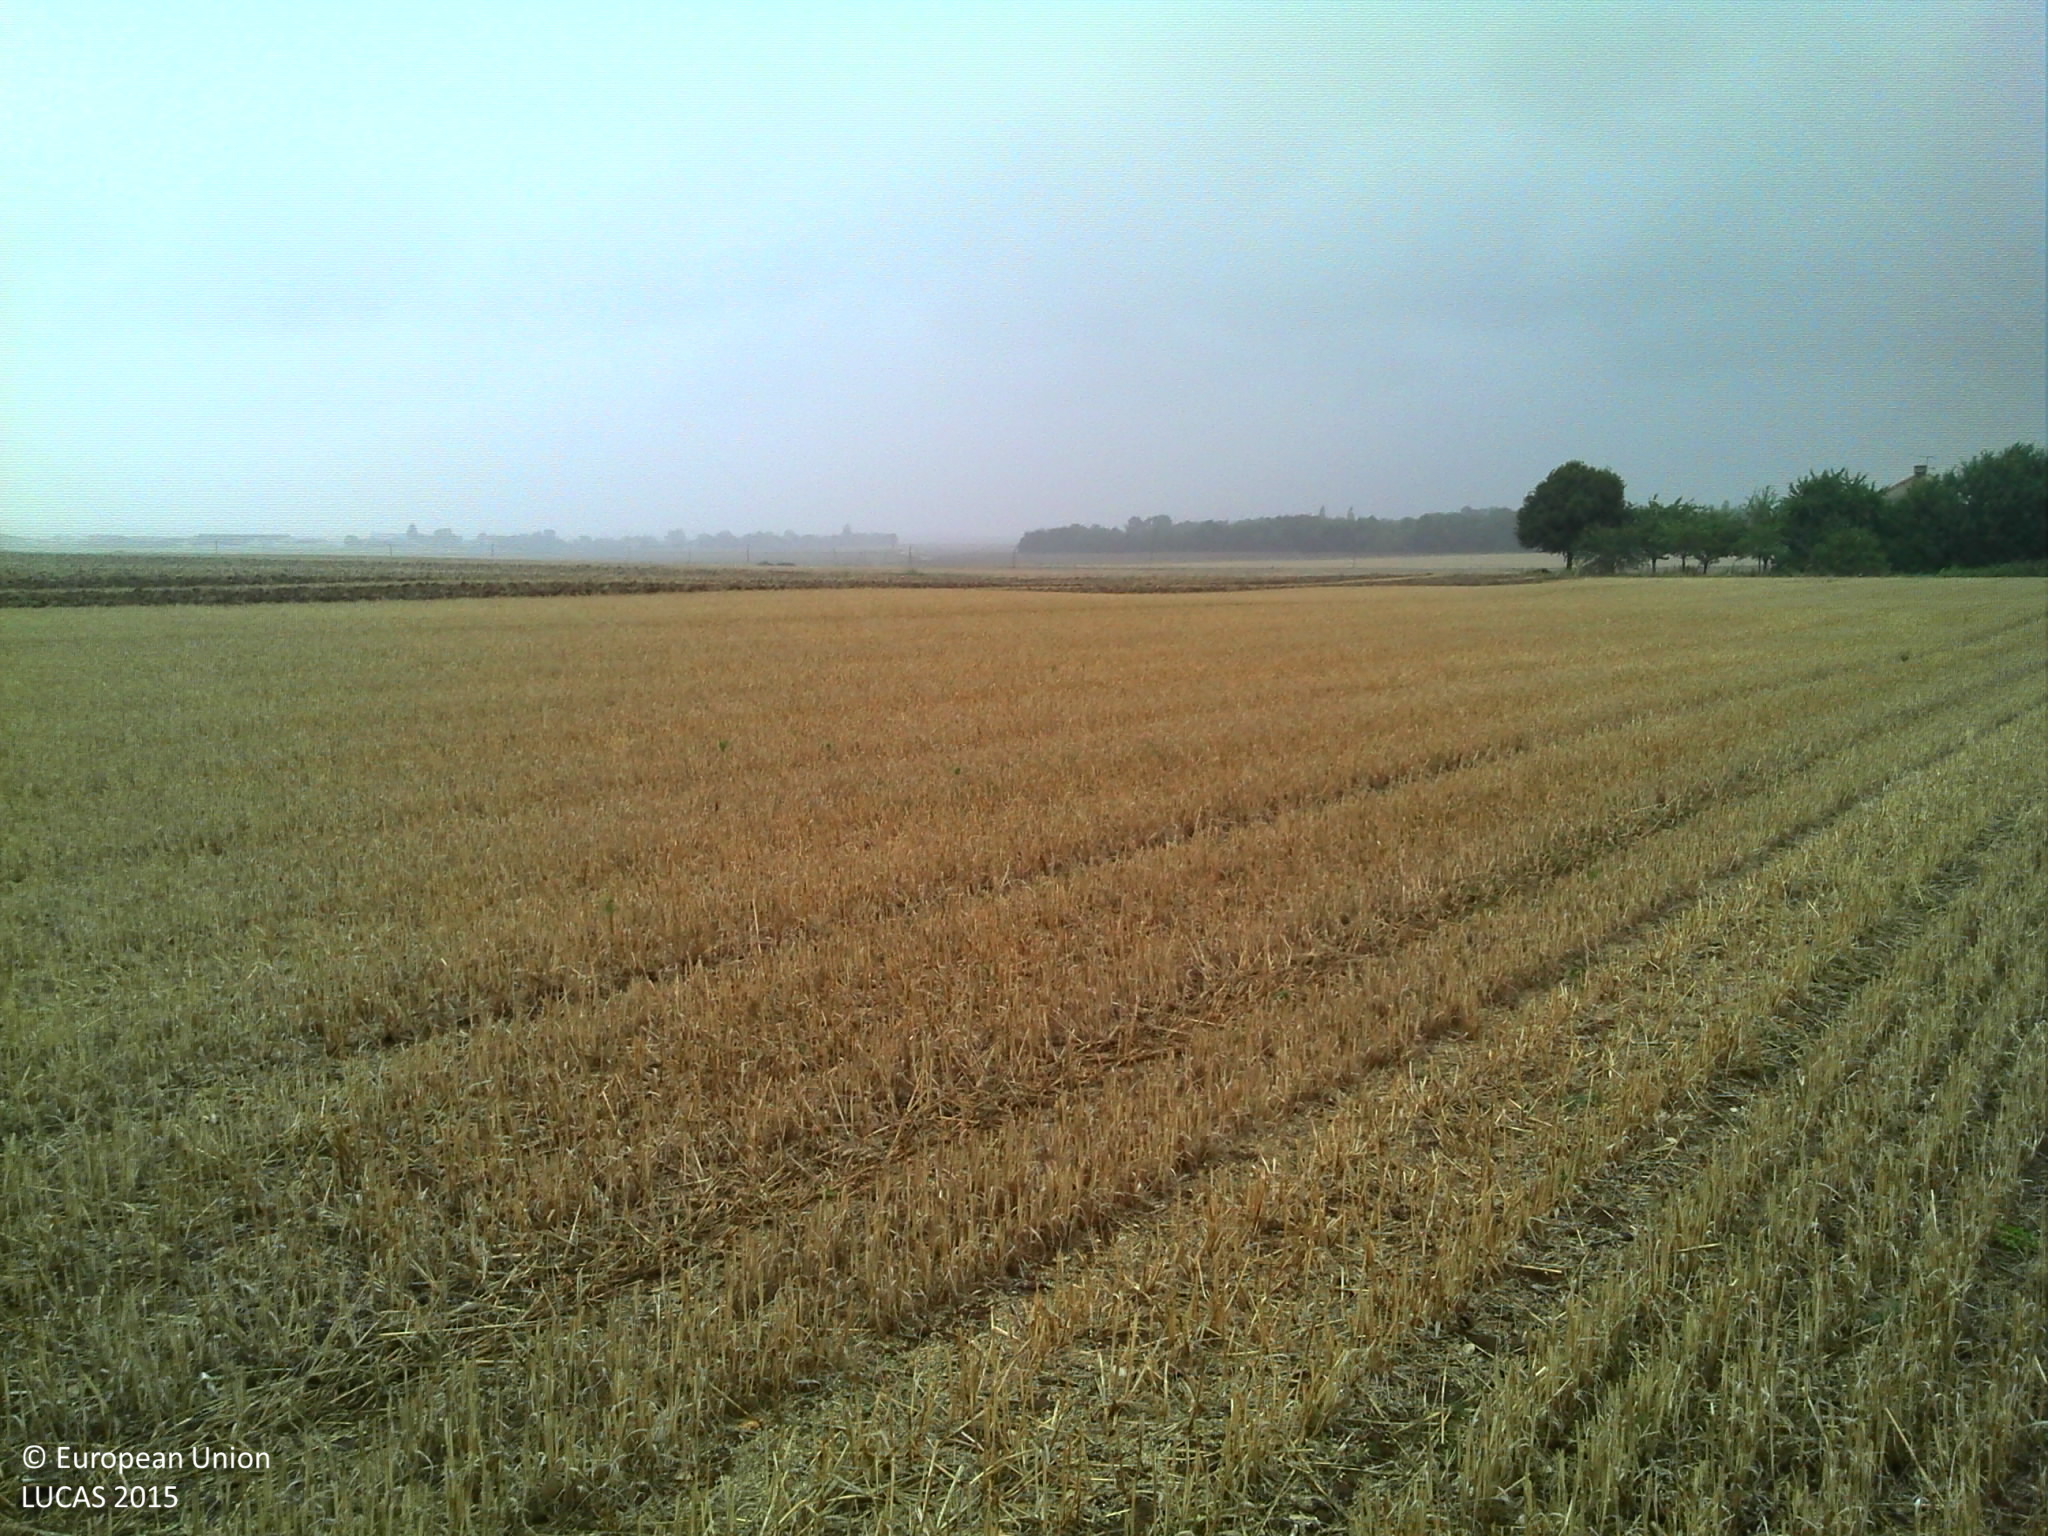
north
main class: Cropland
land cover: Common wheat
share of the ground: < 10 %
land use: Agriculture (excluding fallow land and kitchen gardens)
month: August
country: FR
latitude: 46.7478
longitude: 0.1481
